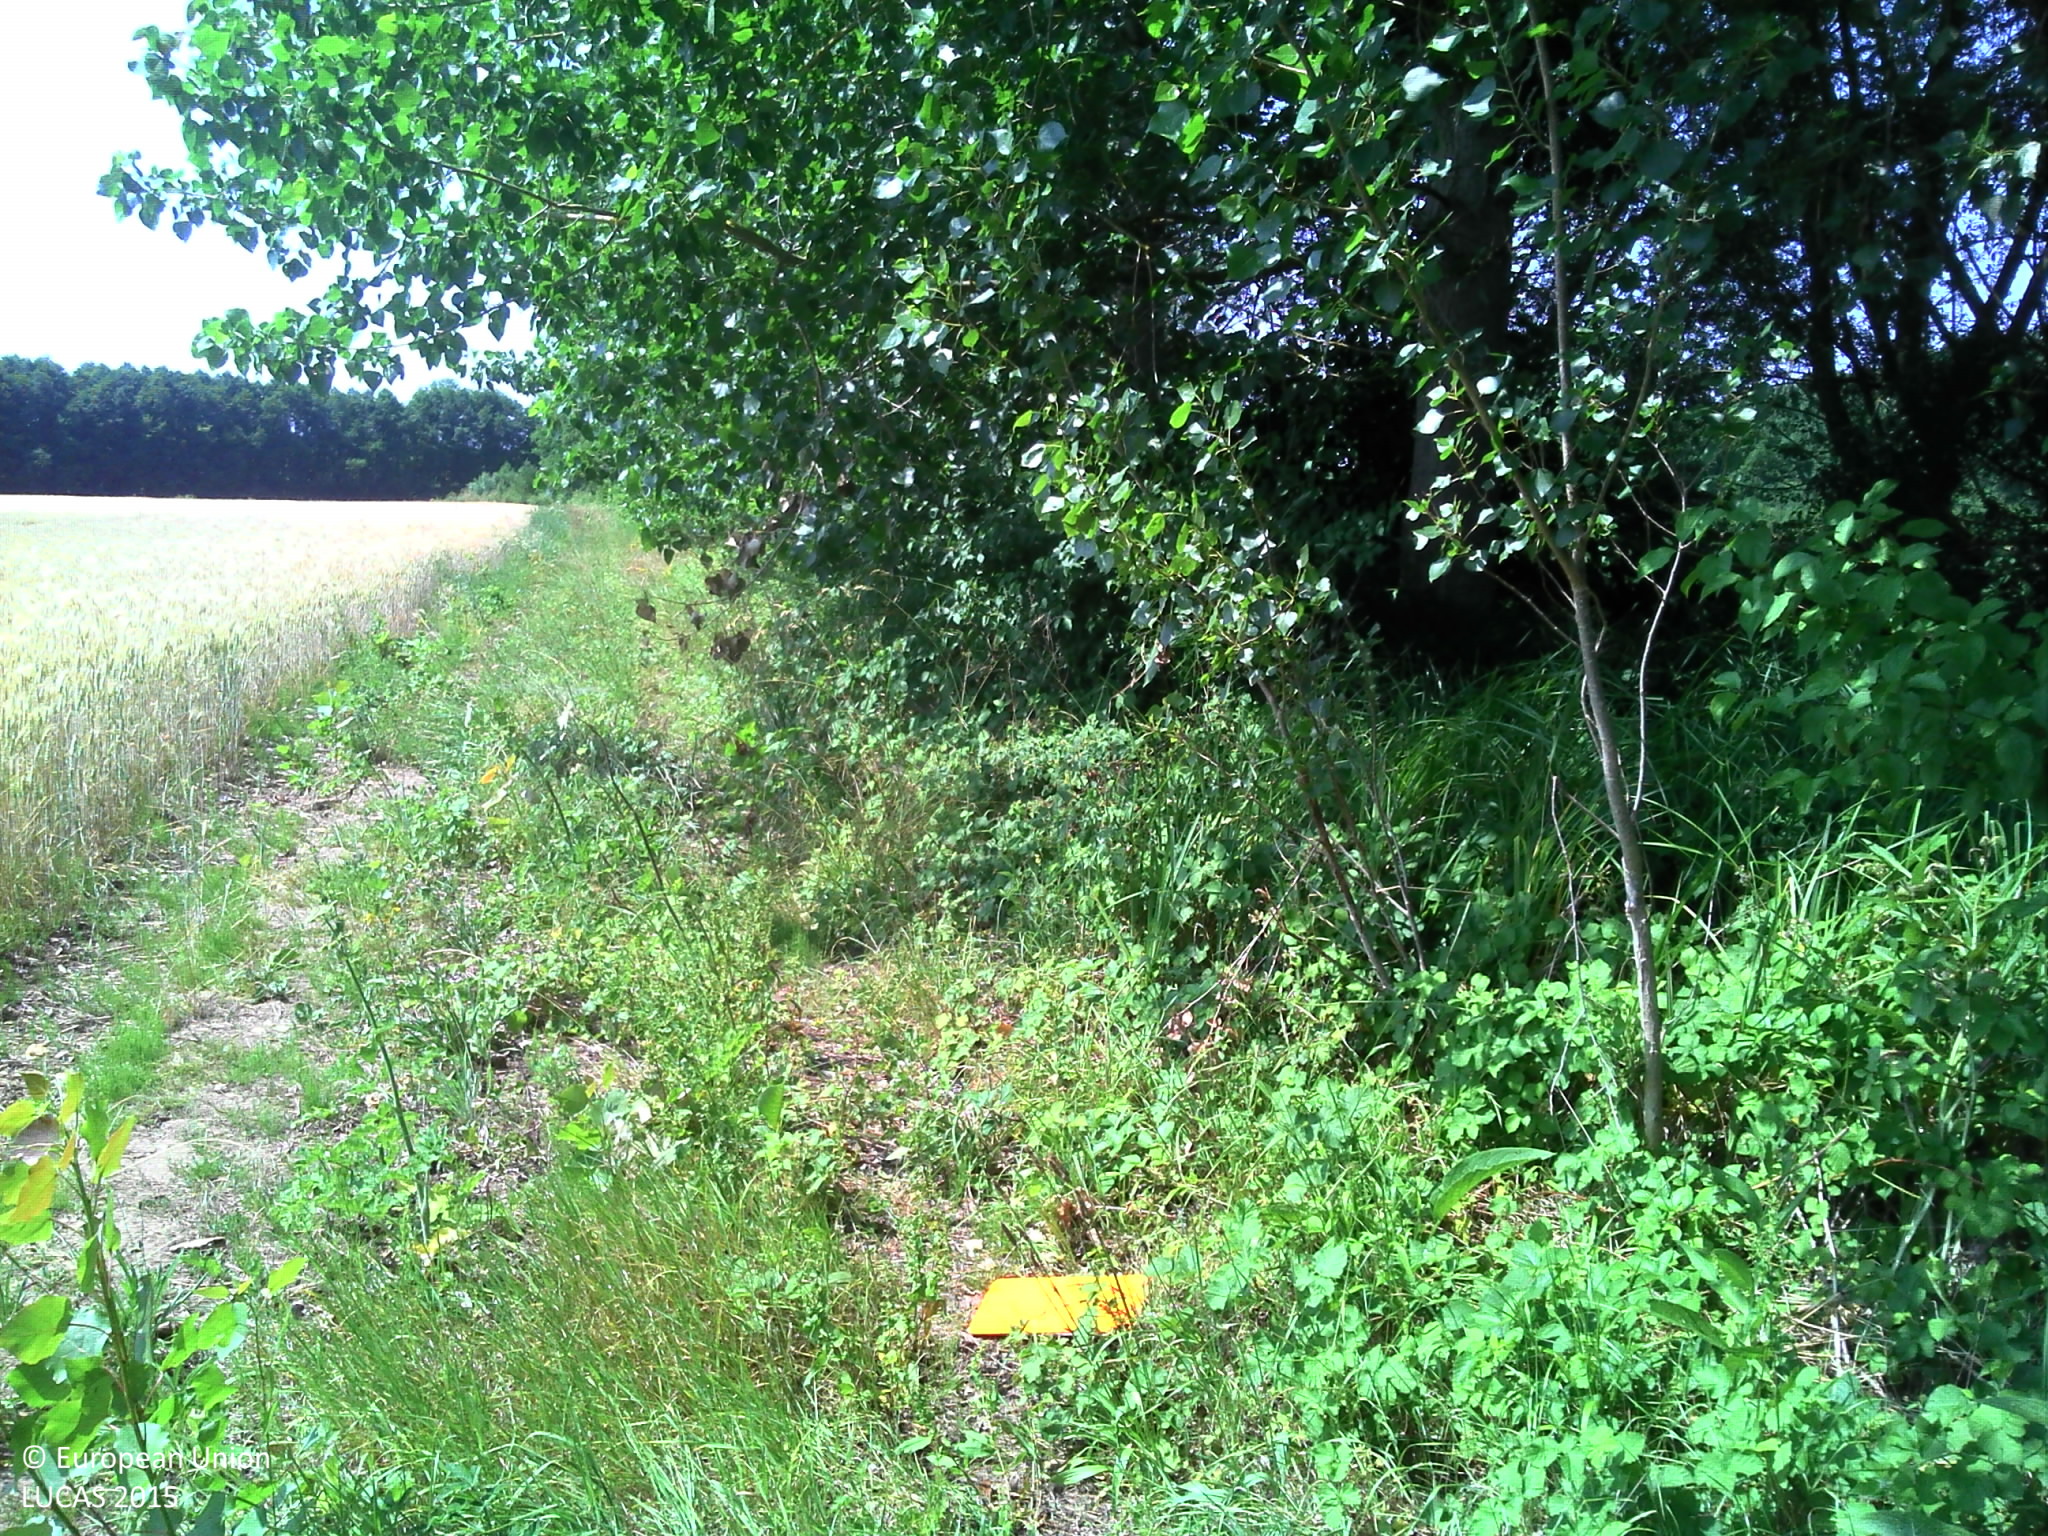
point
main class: Woodland
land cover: Broadleaved woodland
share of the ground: > 75 %
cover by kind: broadleaved forest trees 70 %, herbaceous plants 15 %, consolidated bare surface 15 %
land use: Semi-natural and natural areas not in use
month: July
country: FR
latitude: 48.8068
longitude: 1.3625
